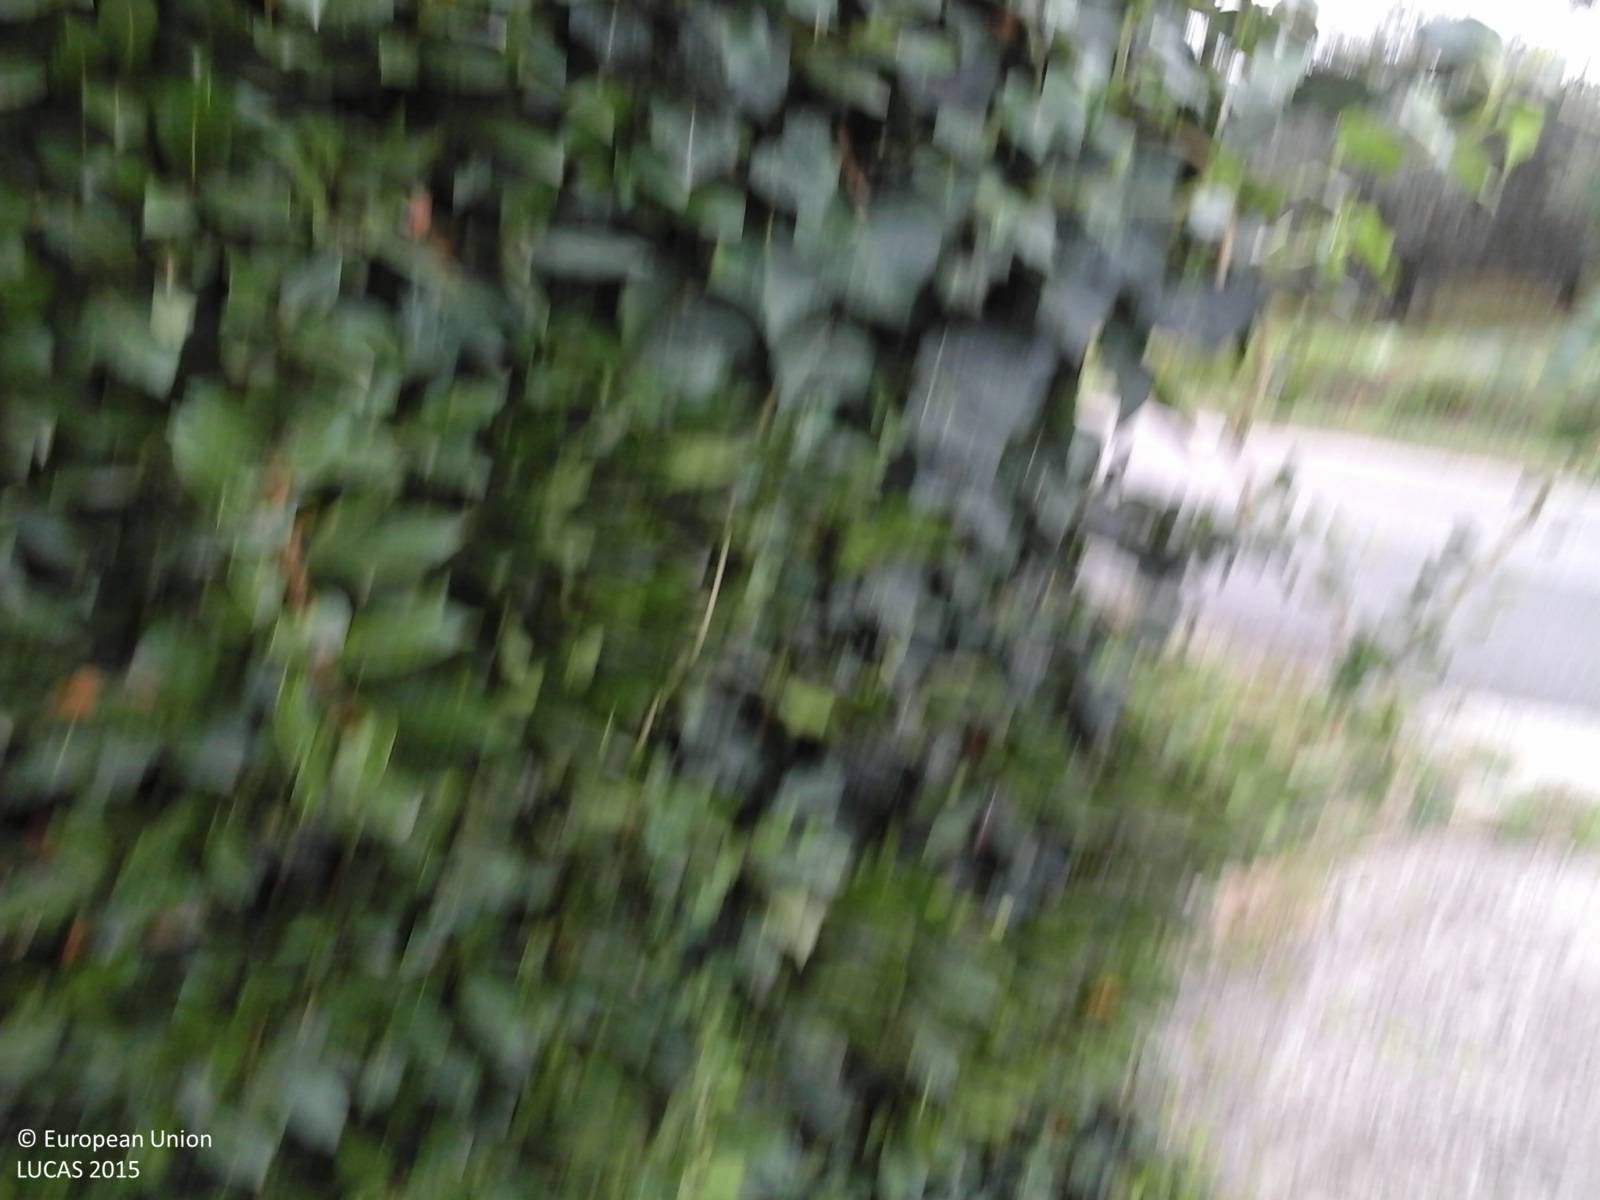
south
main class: Grassland
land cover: Grassland with sparse tree/shrub cover
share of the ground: 25 - 50 %
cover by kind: herbaceous plants 90 %, broadleaved forest trees 5 %, shrubs 5 %
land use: Residential
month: October
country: IT
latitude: 43.1759
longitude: 10.6010
